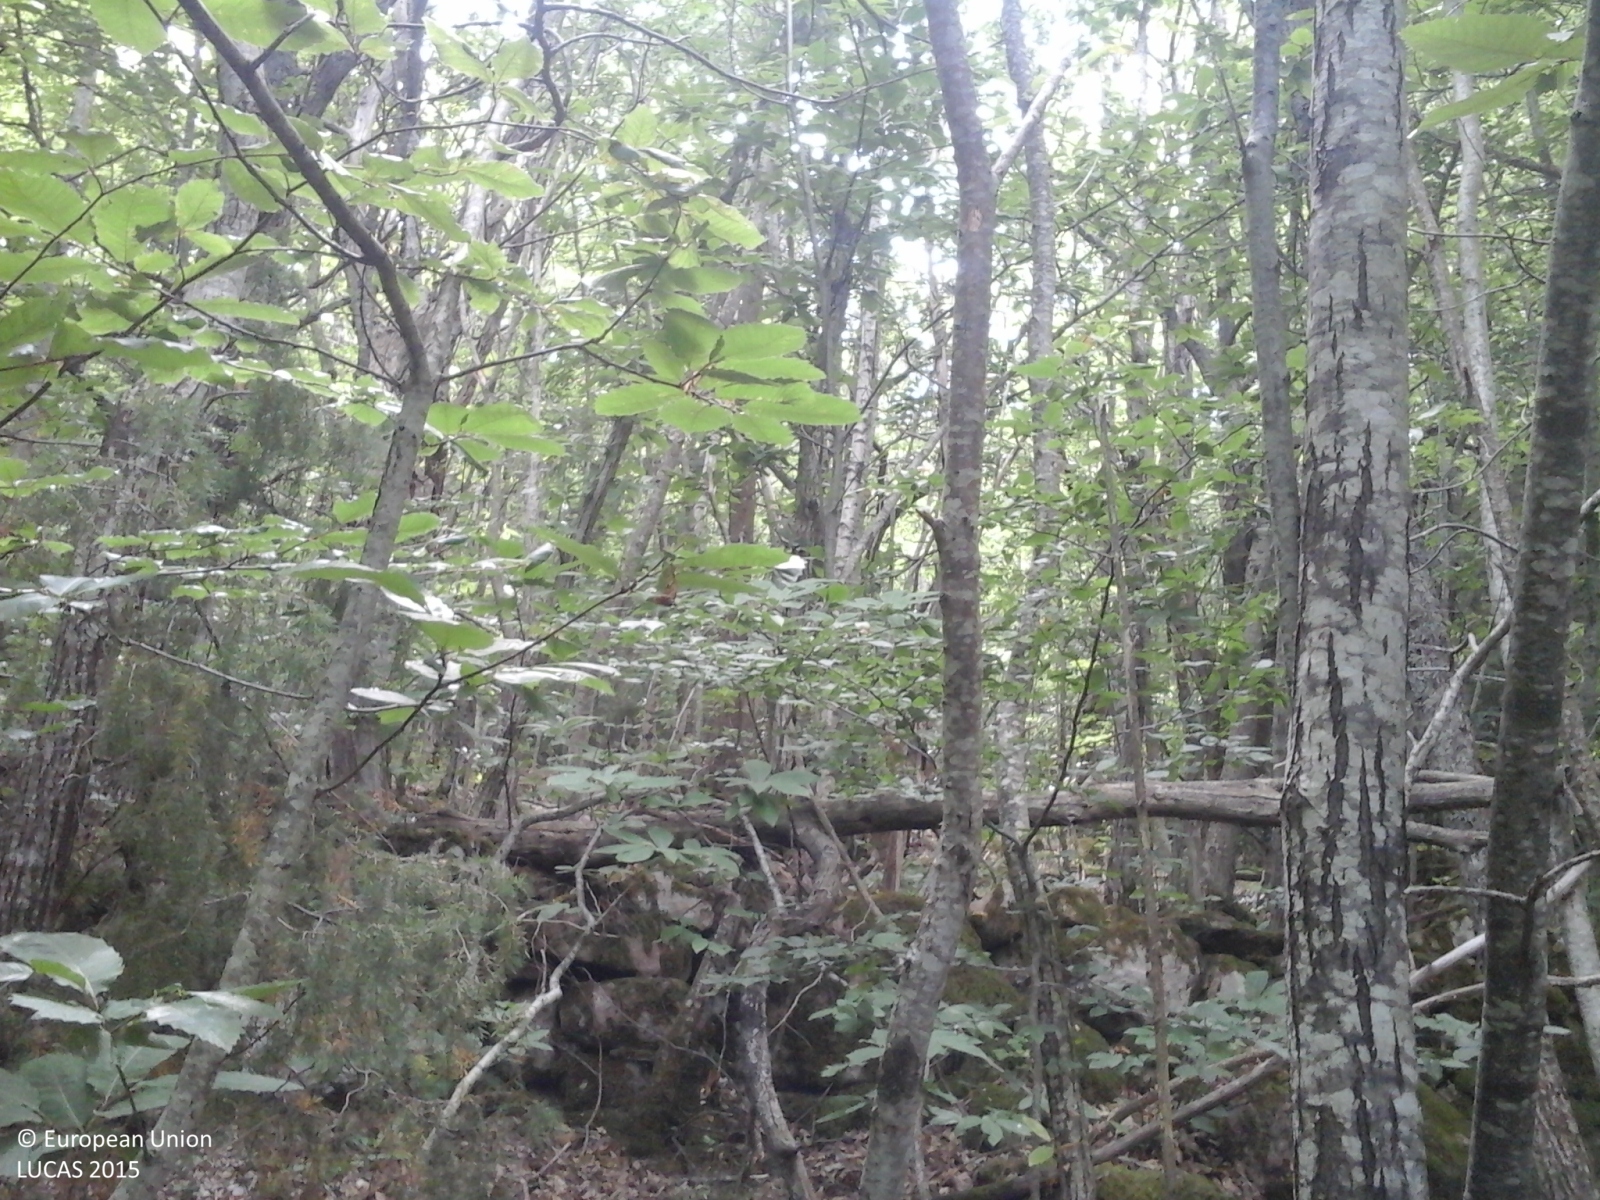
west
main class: Woodland
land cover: Broadleaved woodland
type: thermophilous deciduous forest
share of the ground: > 75 %
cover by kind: broadleaved forest trees 100 %
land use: Forestry
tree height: > 5 m
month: July
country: IT
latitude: 44.1864
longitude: 10.6115
